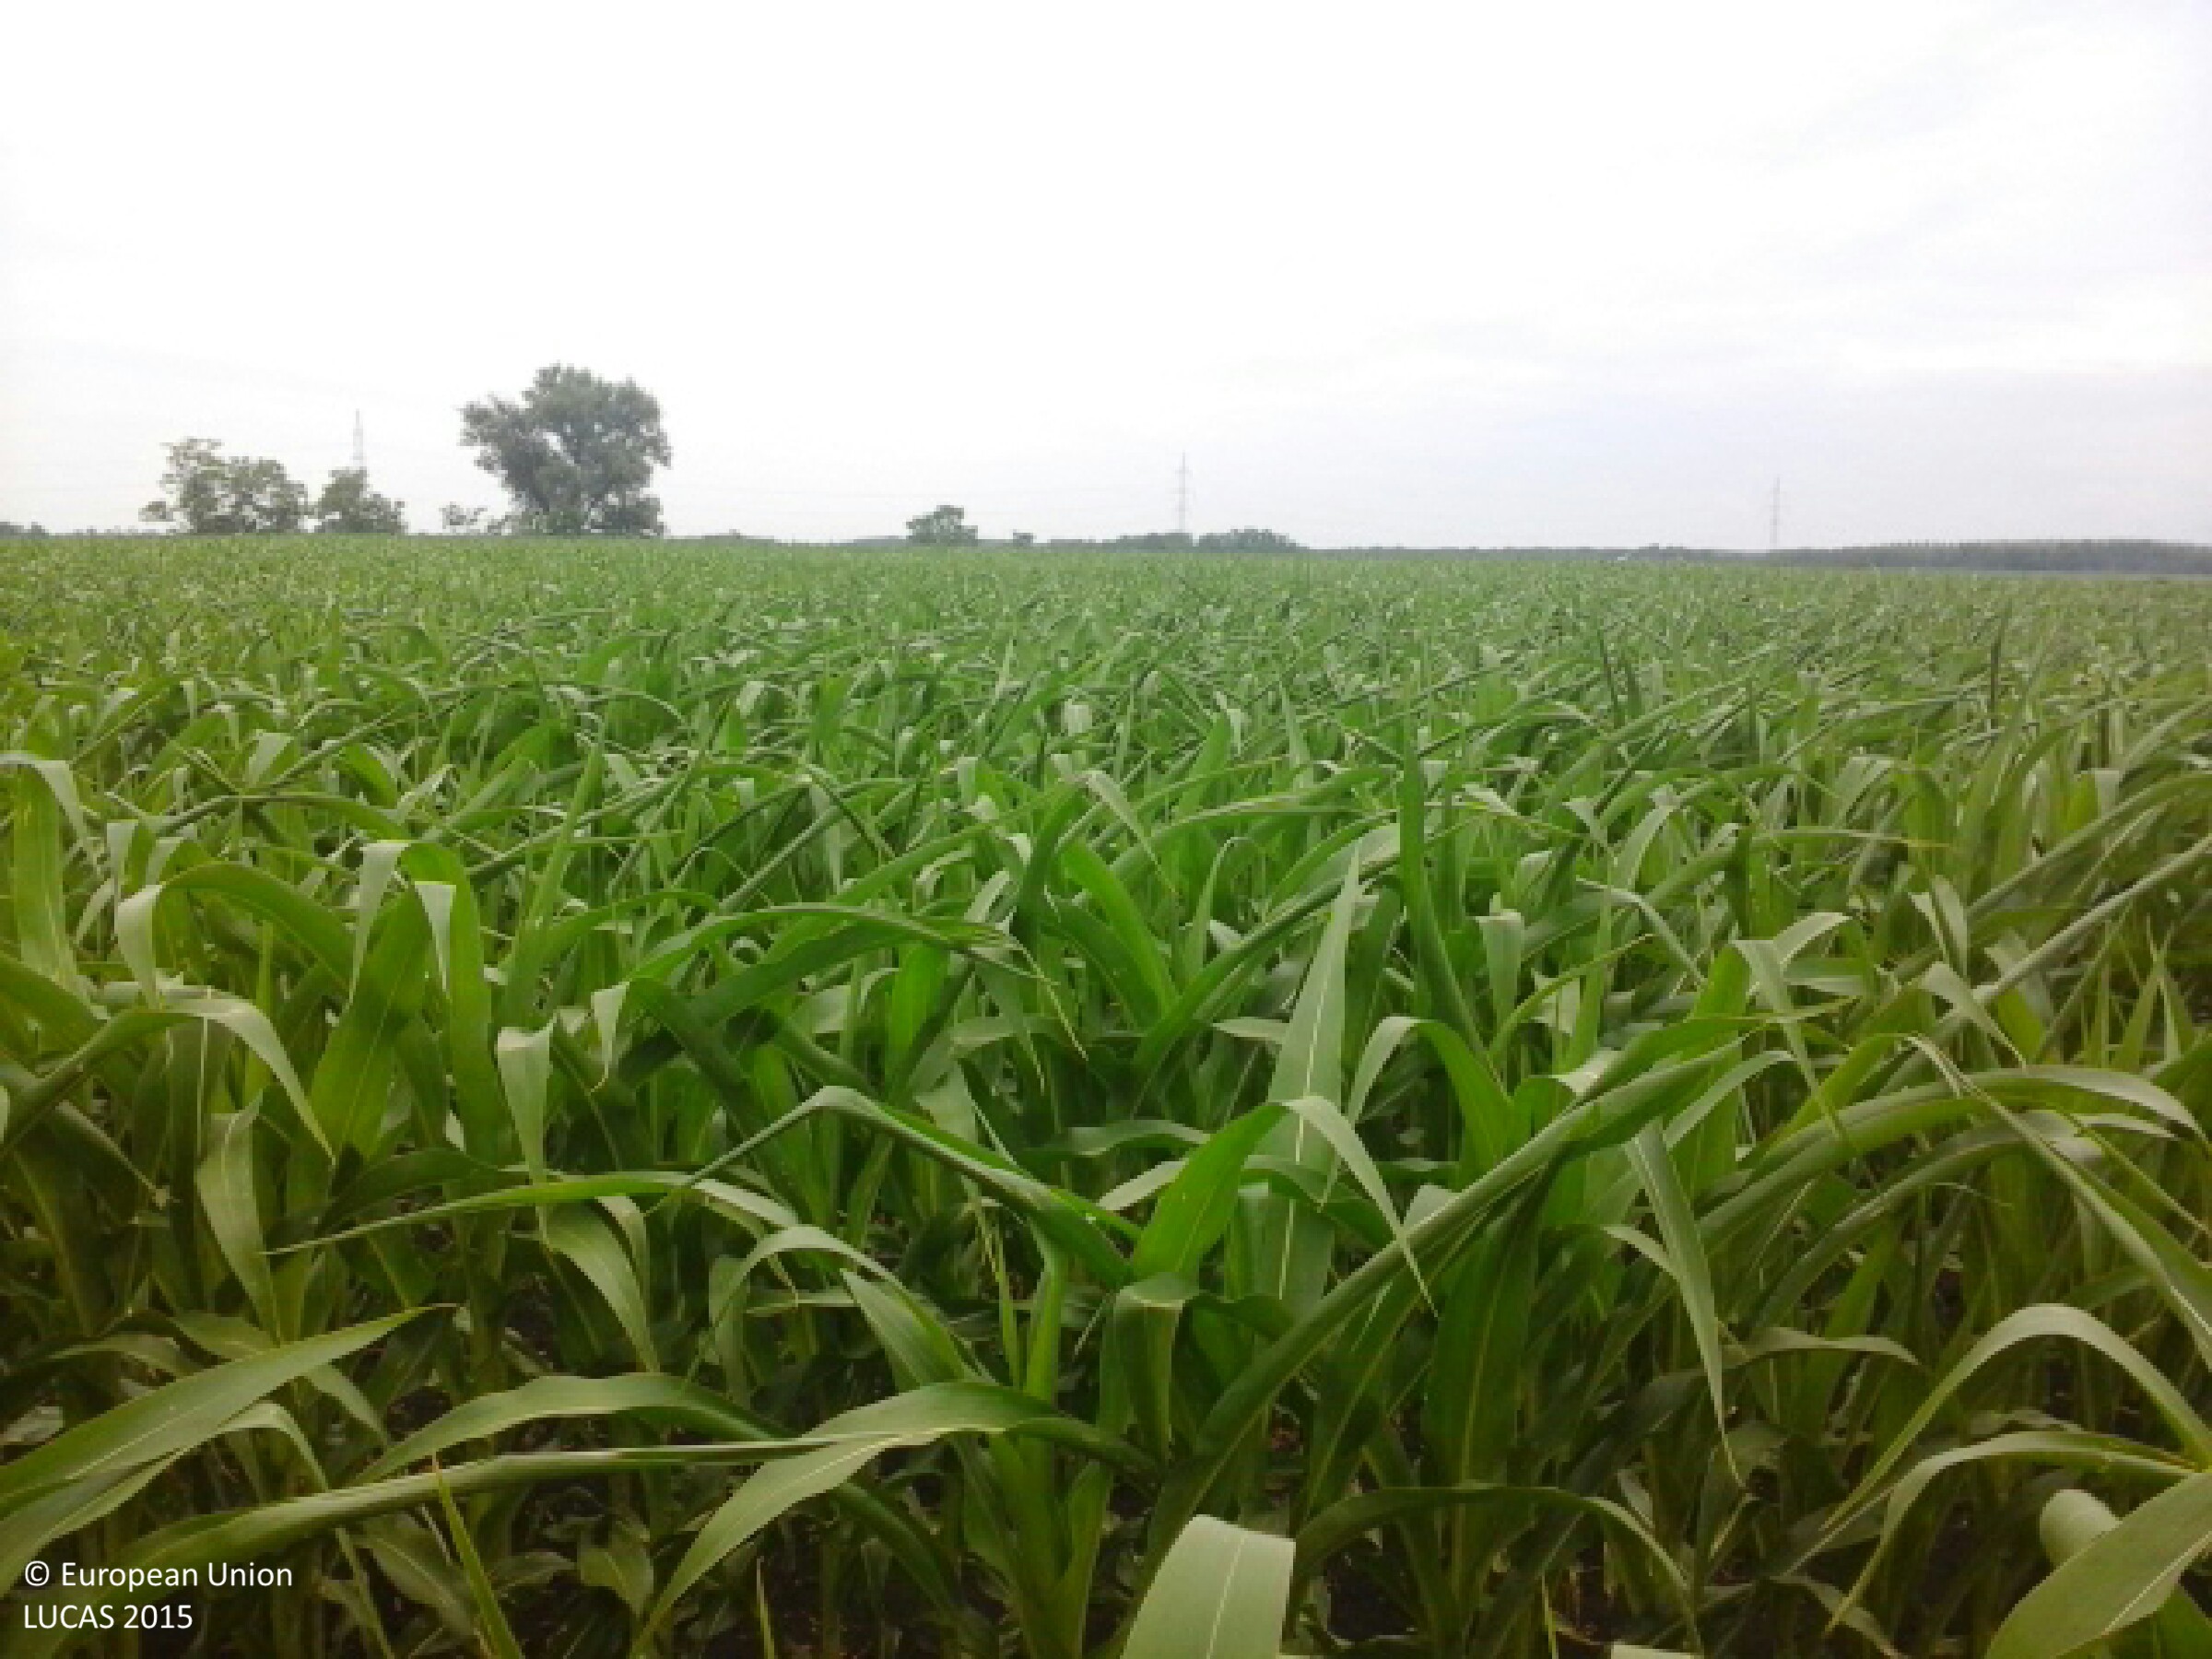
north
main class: Cropland
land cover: Maize
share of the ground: > 75 %
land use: Agriculture (excluding fallow land and kitchen gardens)
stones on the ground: < 10 %
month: June
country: HU
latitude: 48.1440
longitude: 21.8644
